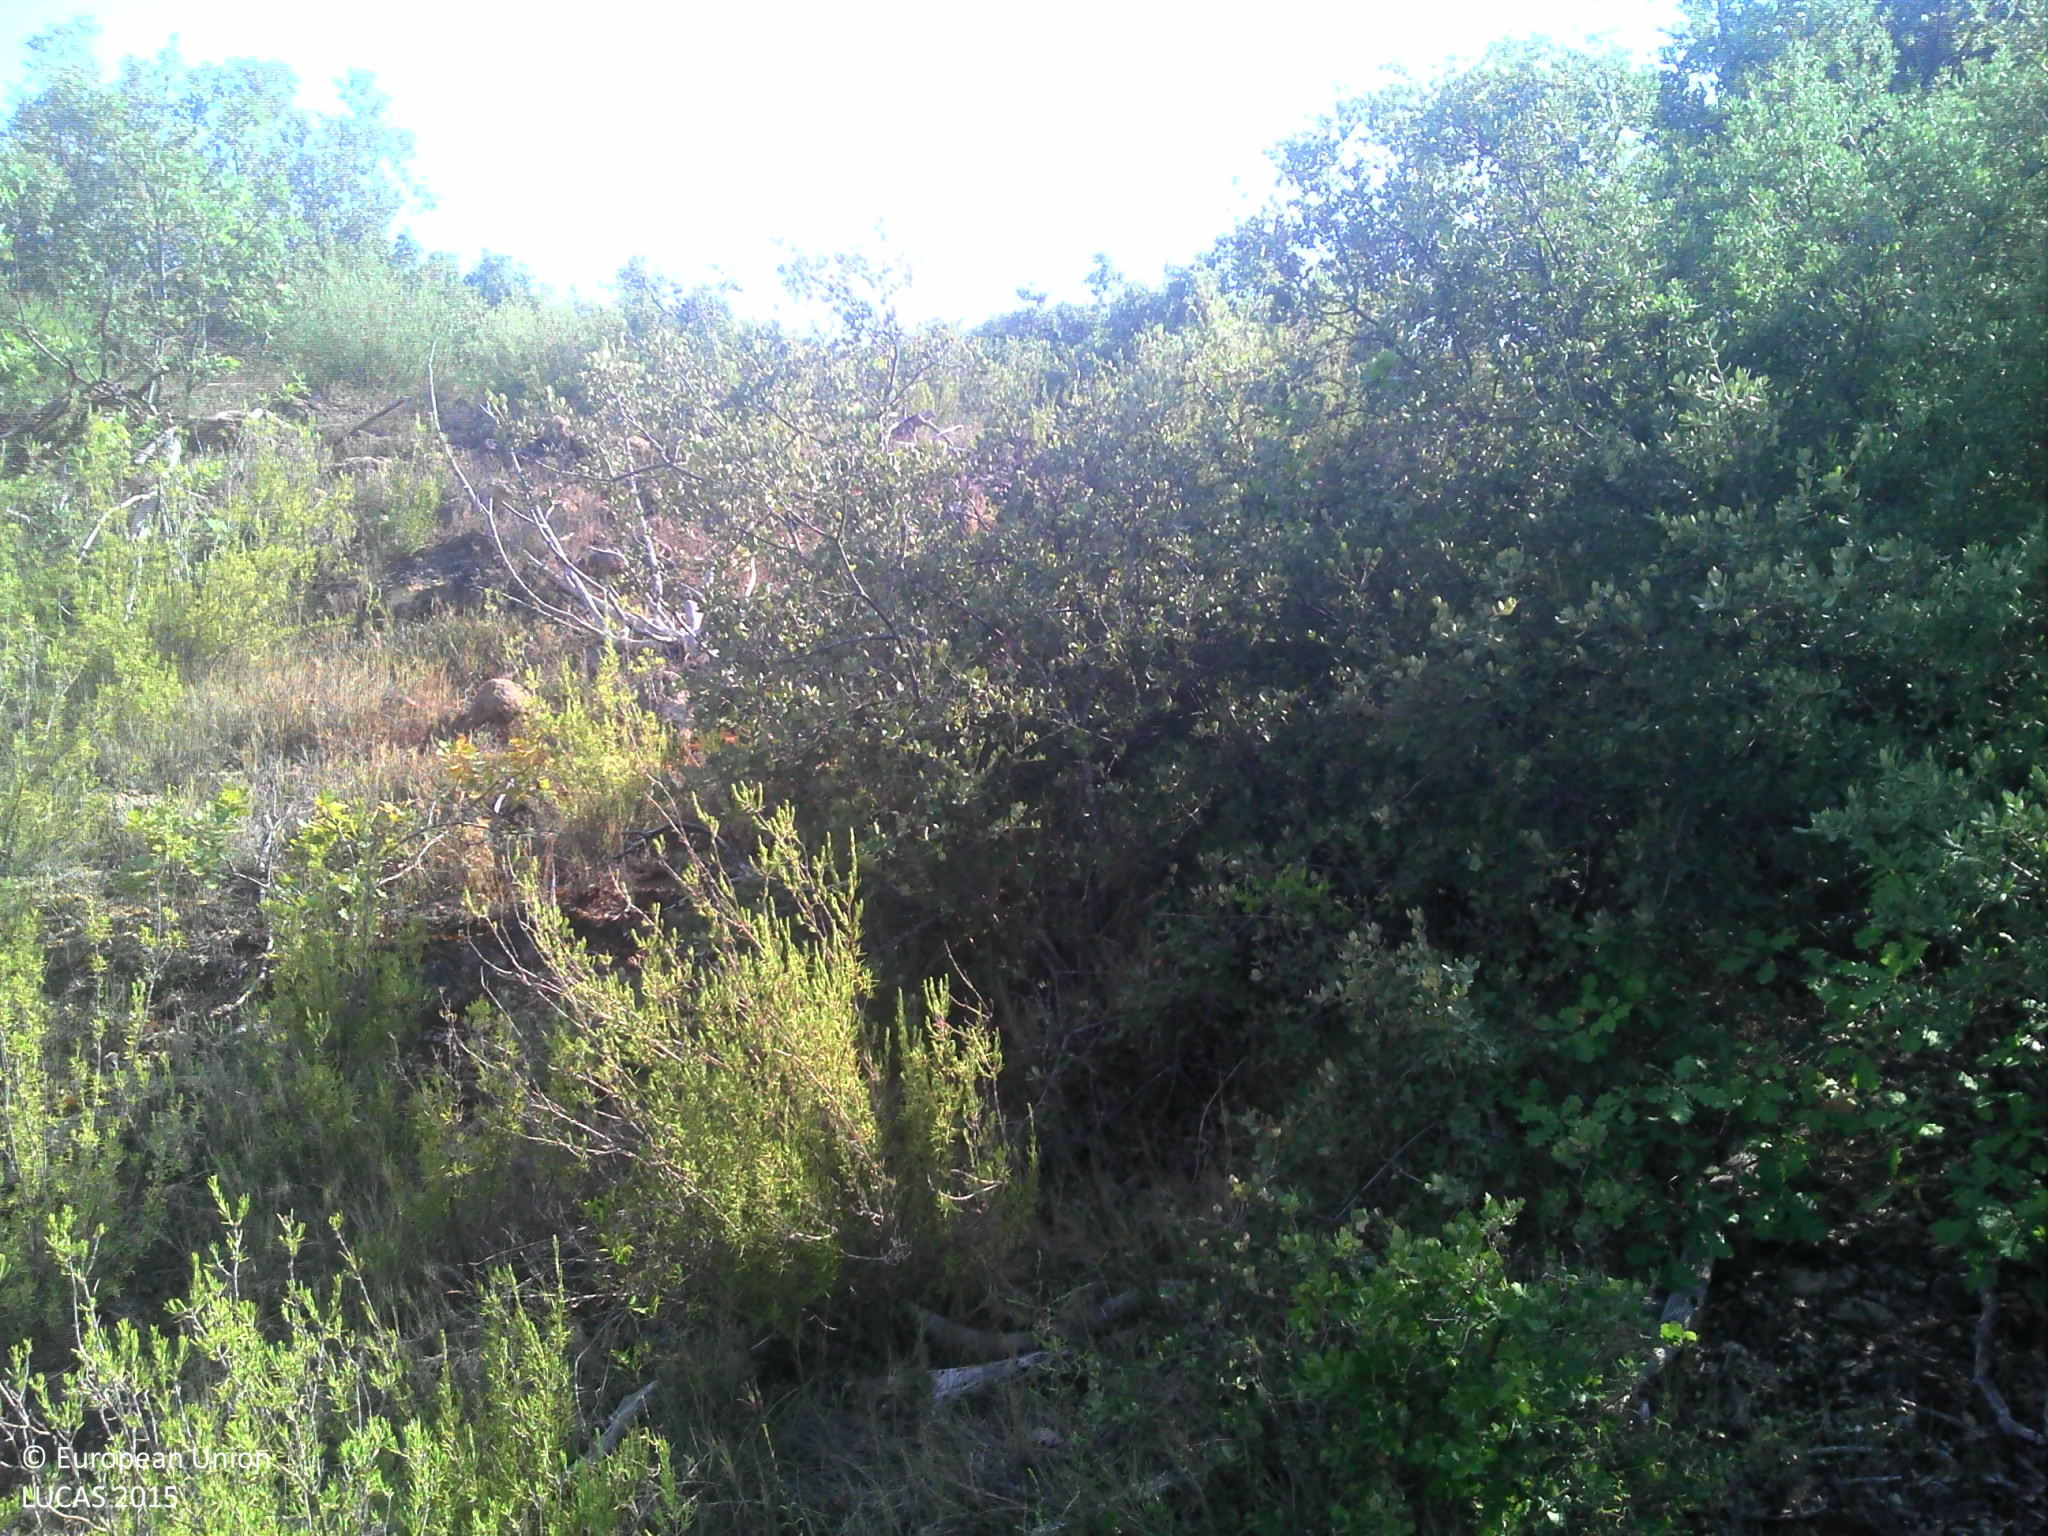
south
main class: Shrubland
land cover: Shrubland with sparse tree cover
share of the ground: > 75 %
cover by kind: shrubs 50 %, herbaceous plants 30 %, unconsolidated bare surface 10 %, broadleaved forest trees 5 %, lichens and mosses 5 %
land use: Forestry
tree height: < 5 m
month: August
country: FR
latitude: 43.6264
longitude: 5.6344
